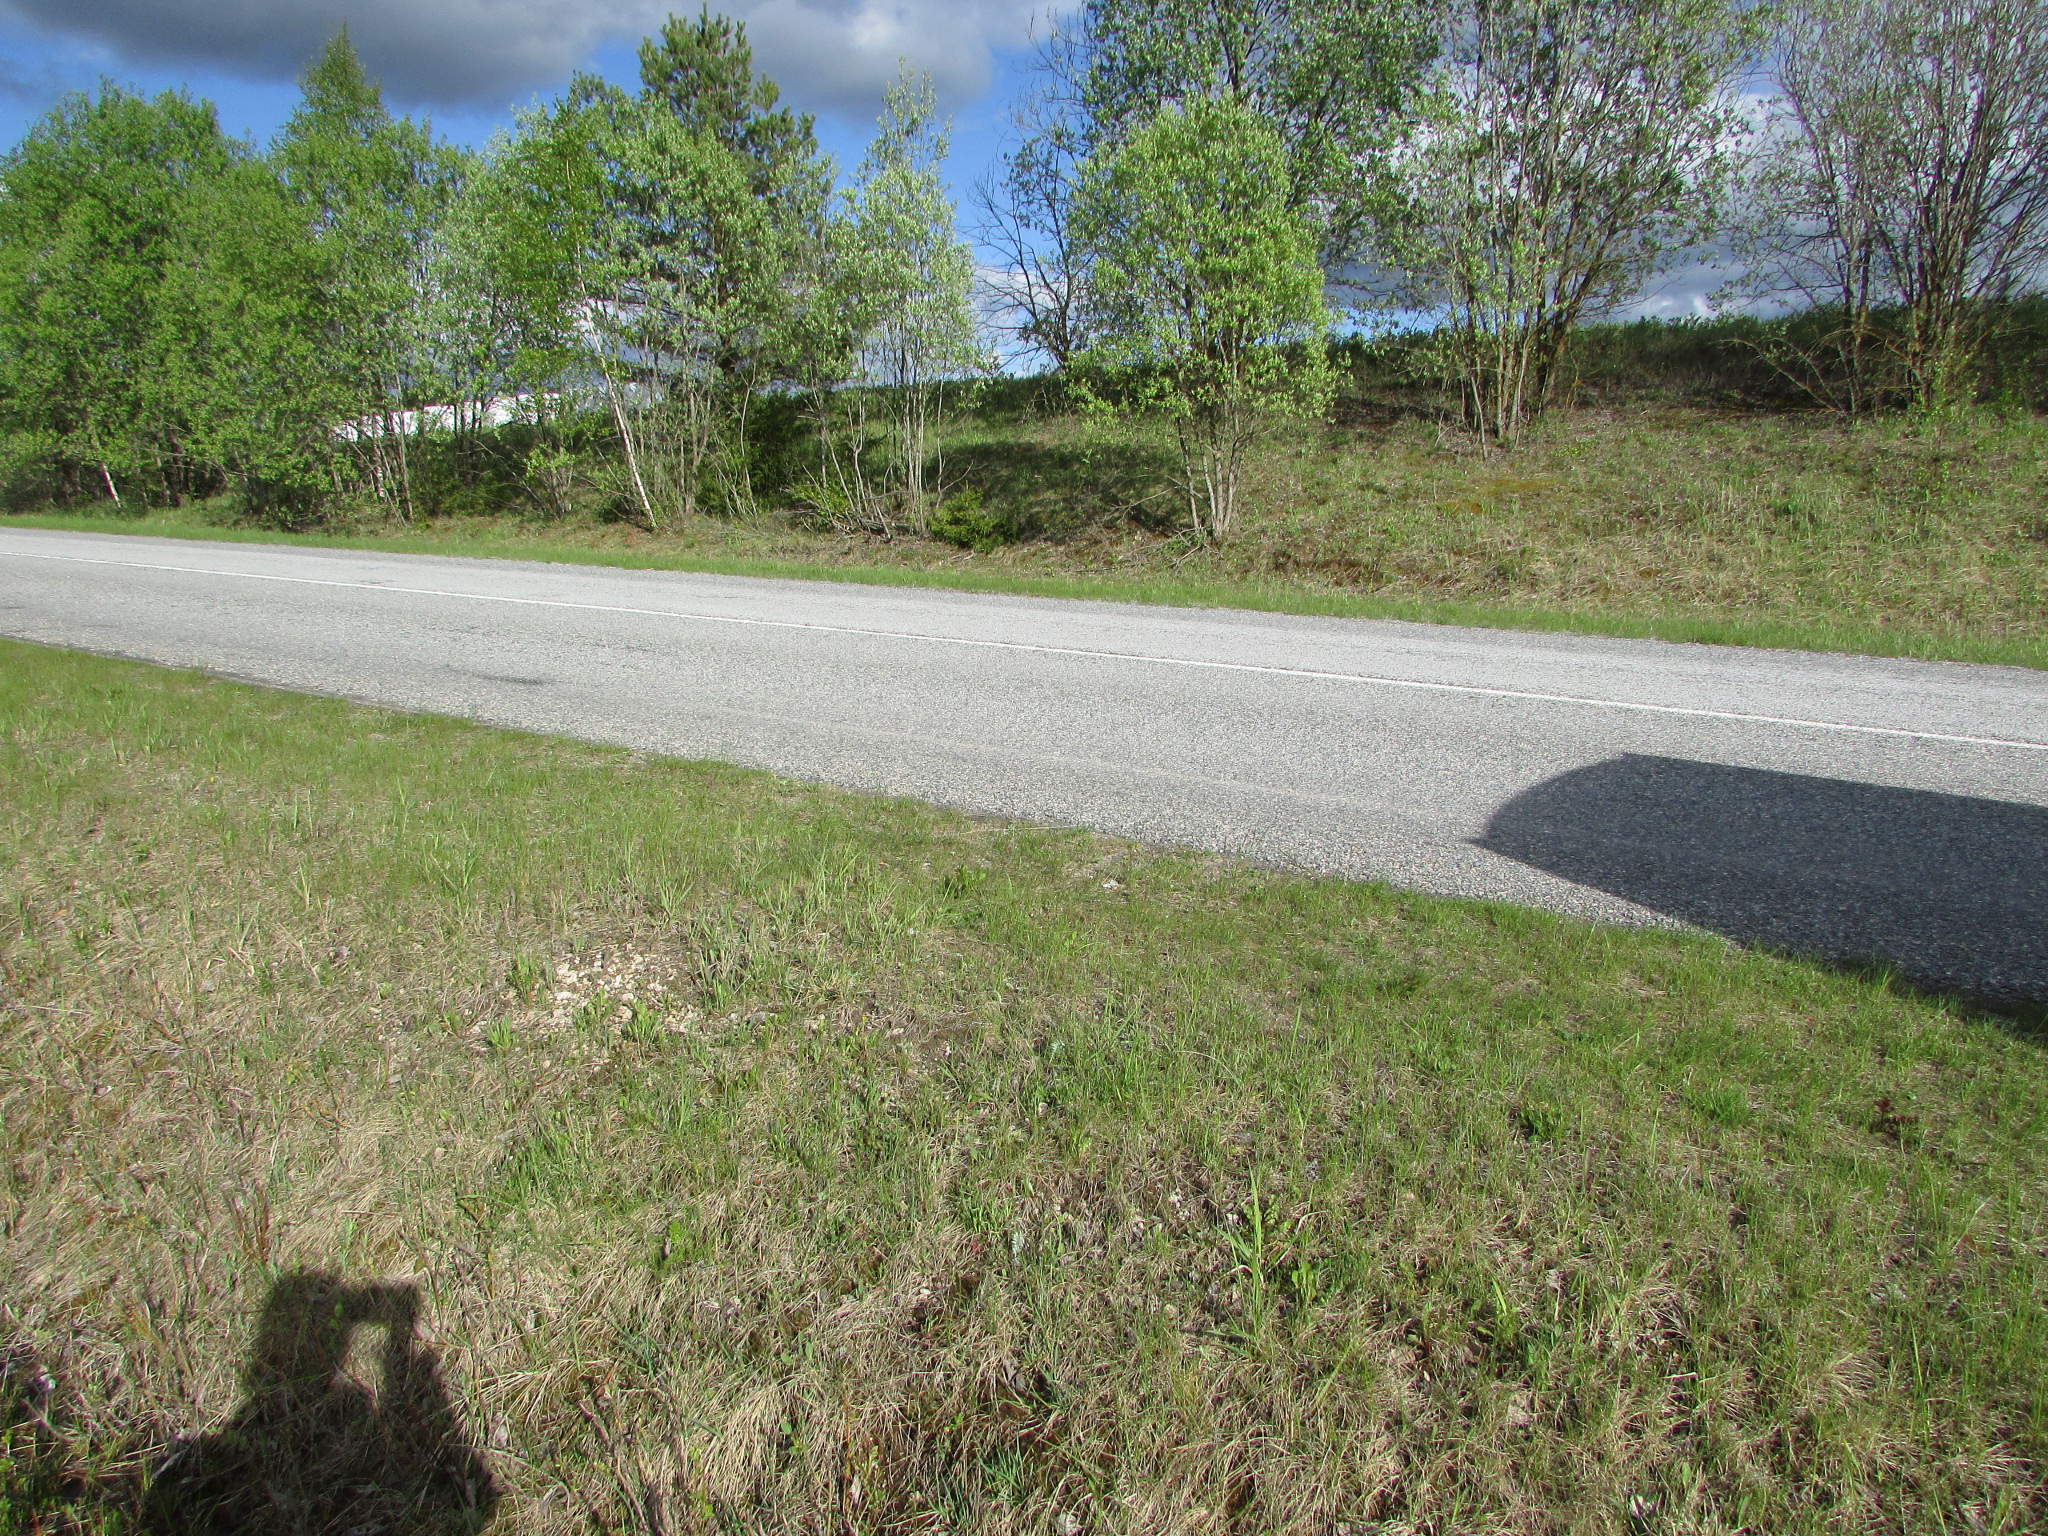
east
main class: Grassland
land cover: Grassland without tree/shrub cover
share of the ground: > 75 %
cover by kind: herbaceous plants 100 %
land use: Agriculture (excluding fallow land and kitchen gardens)
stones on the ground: < 10 %
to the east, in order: Grassland without tree/shrub cover; Paved roads, cycling and walking lanes; Grass margins; Broadleaved woodland; Grassland without tree/shrub cover; Broadleaved woodland; Tracks; Grassland without tree/shrub cover
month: May
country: LV
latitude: 56.1356
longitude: 27.0791
